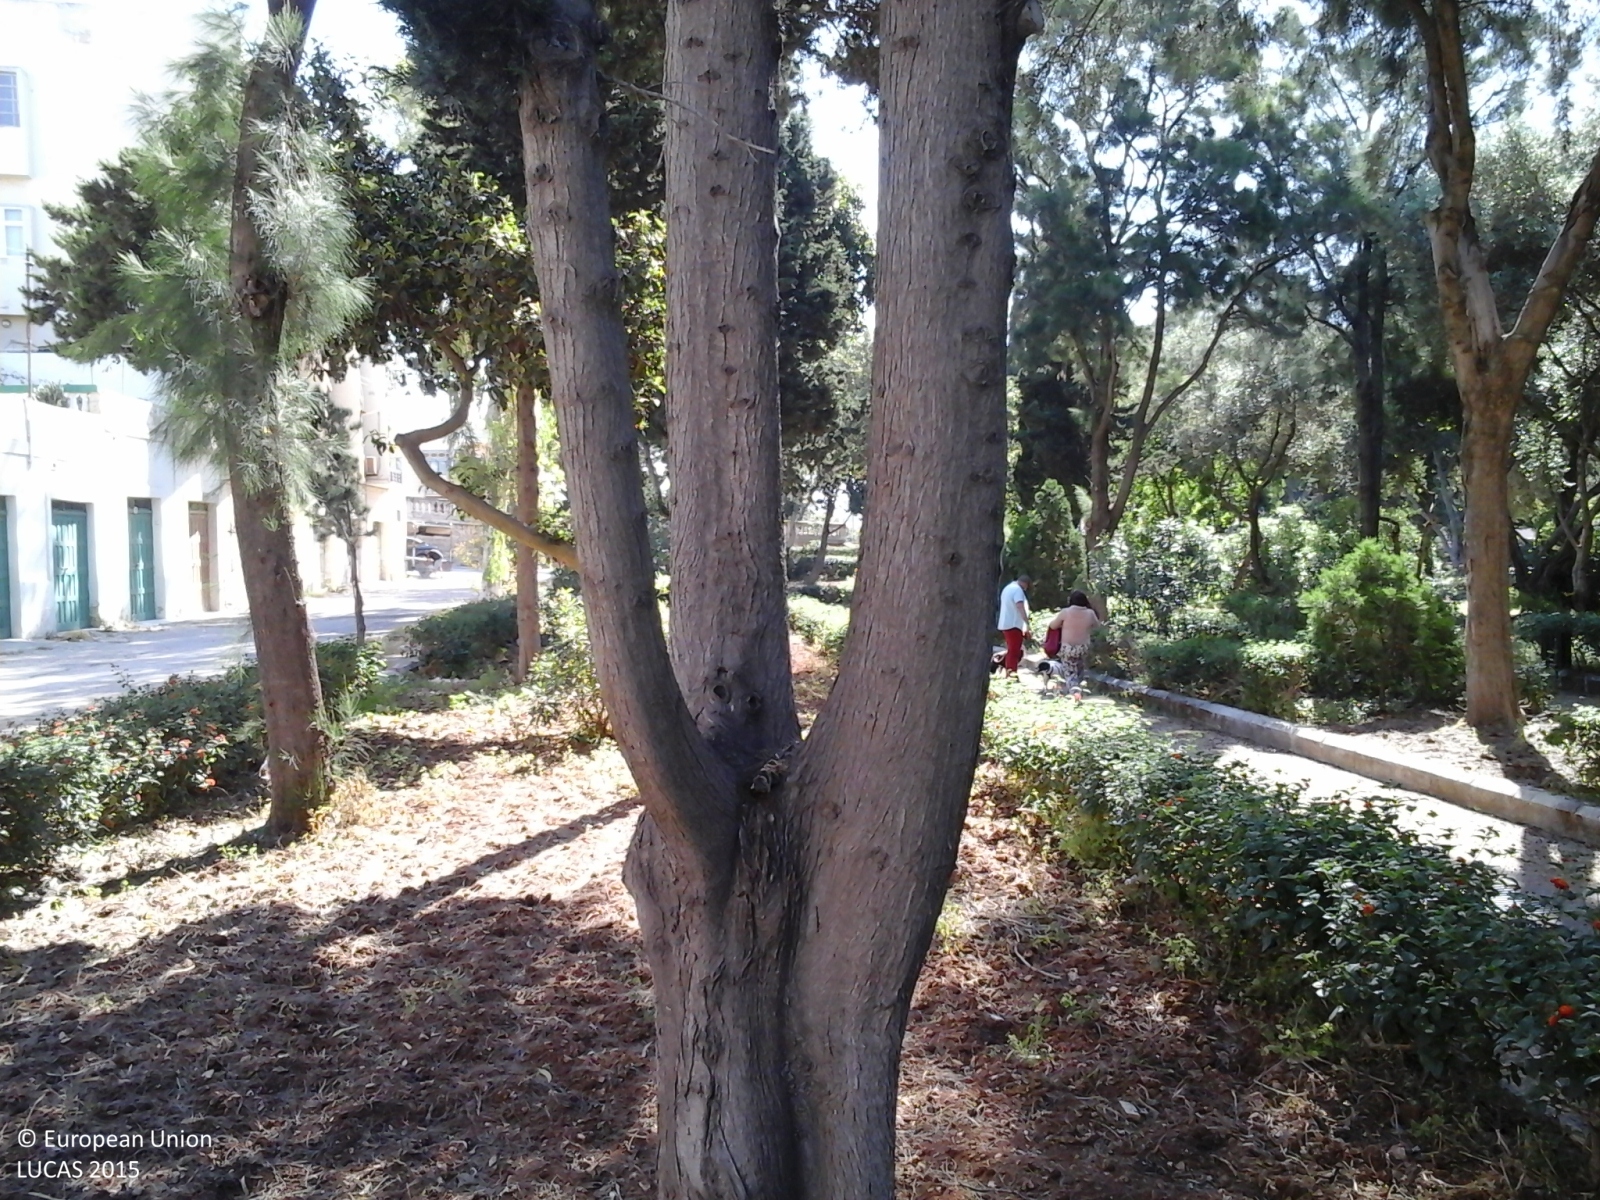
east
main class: Woodland
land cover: Pine dominated coniferous woodland
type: coniferous forest of the mediterranean region
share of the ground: 50 - 75 %
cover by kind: coniferous forest trees 100 %
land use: Amenities, museums, leisure
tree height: > 5 m
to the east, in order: Pine dominated coniferous woodland; Paved roads, cycling and walking lanes; Pine dominated coniferous woodland; Paved roads, cycling and walking lanes; Lines of trees; Paved roads, cycling and walking lanes; Lines of trees; Paved roads, cycling and walking lanes; Grassland without tree/shrub cover; Broadleaved woodland; Grassland with sparse tree/shrub cover; Ditches and canals; Grassland with sparse tree/shrub cover
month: May
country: MT
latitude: 35.8753
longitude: 14.5105
